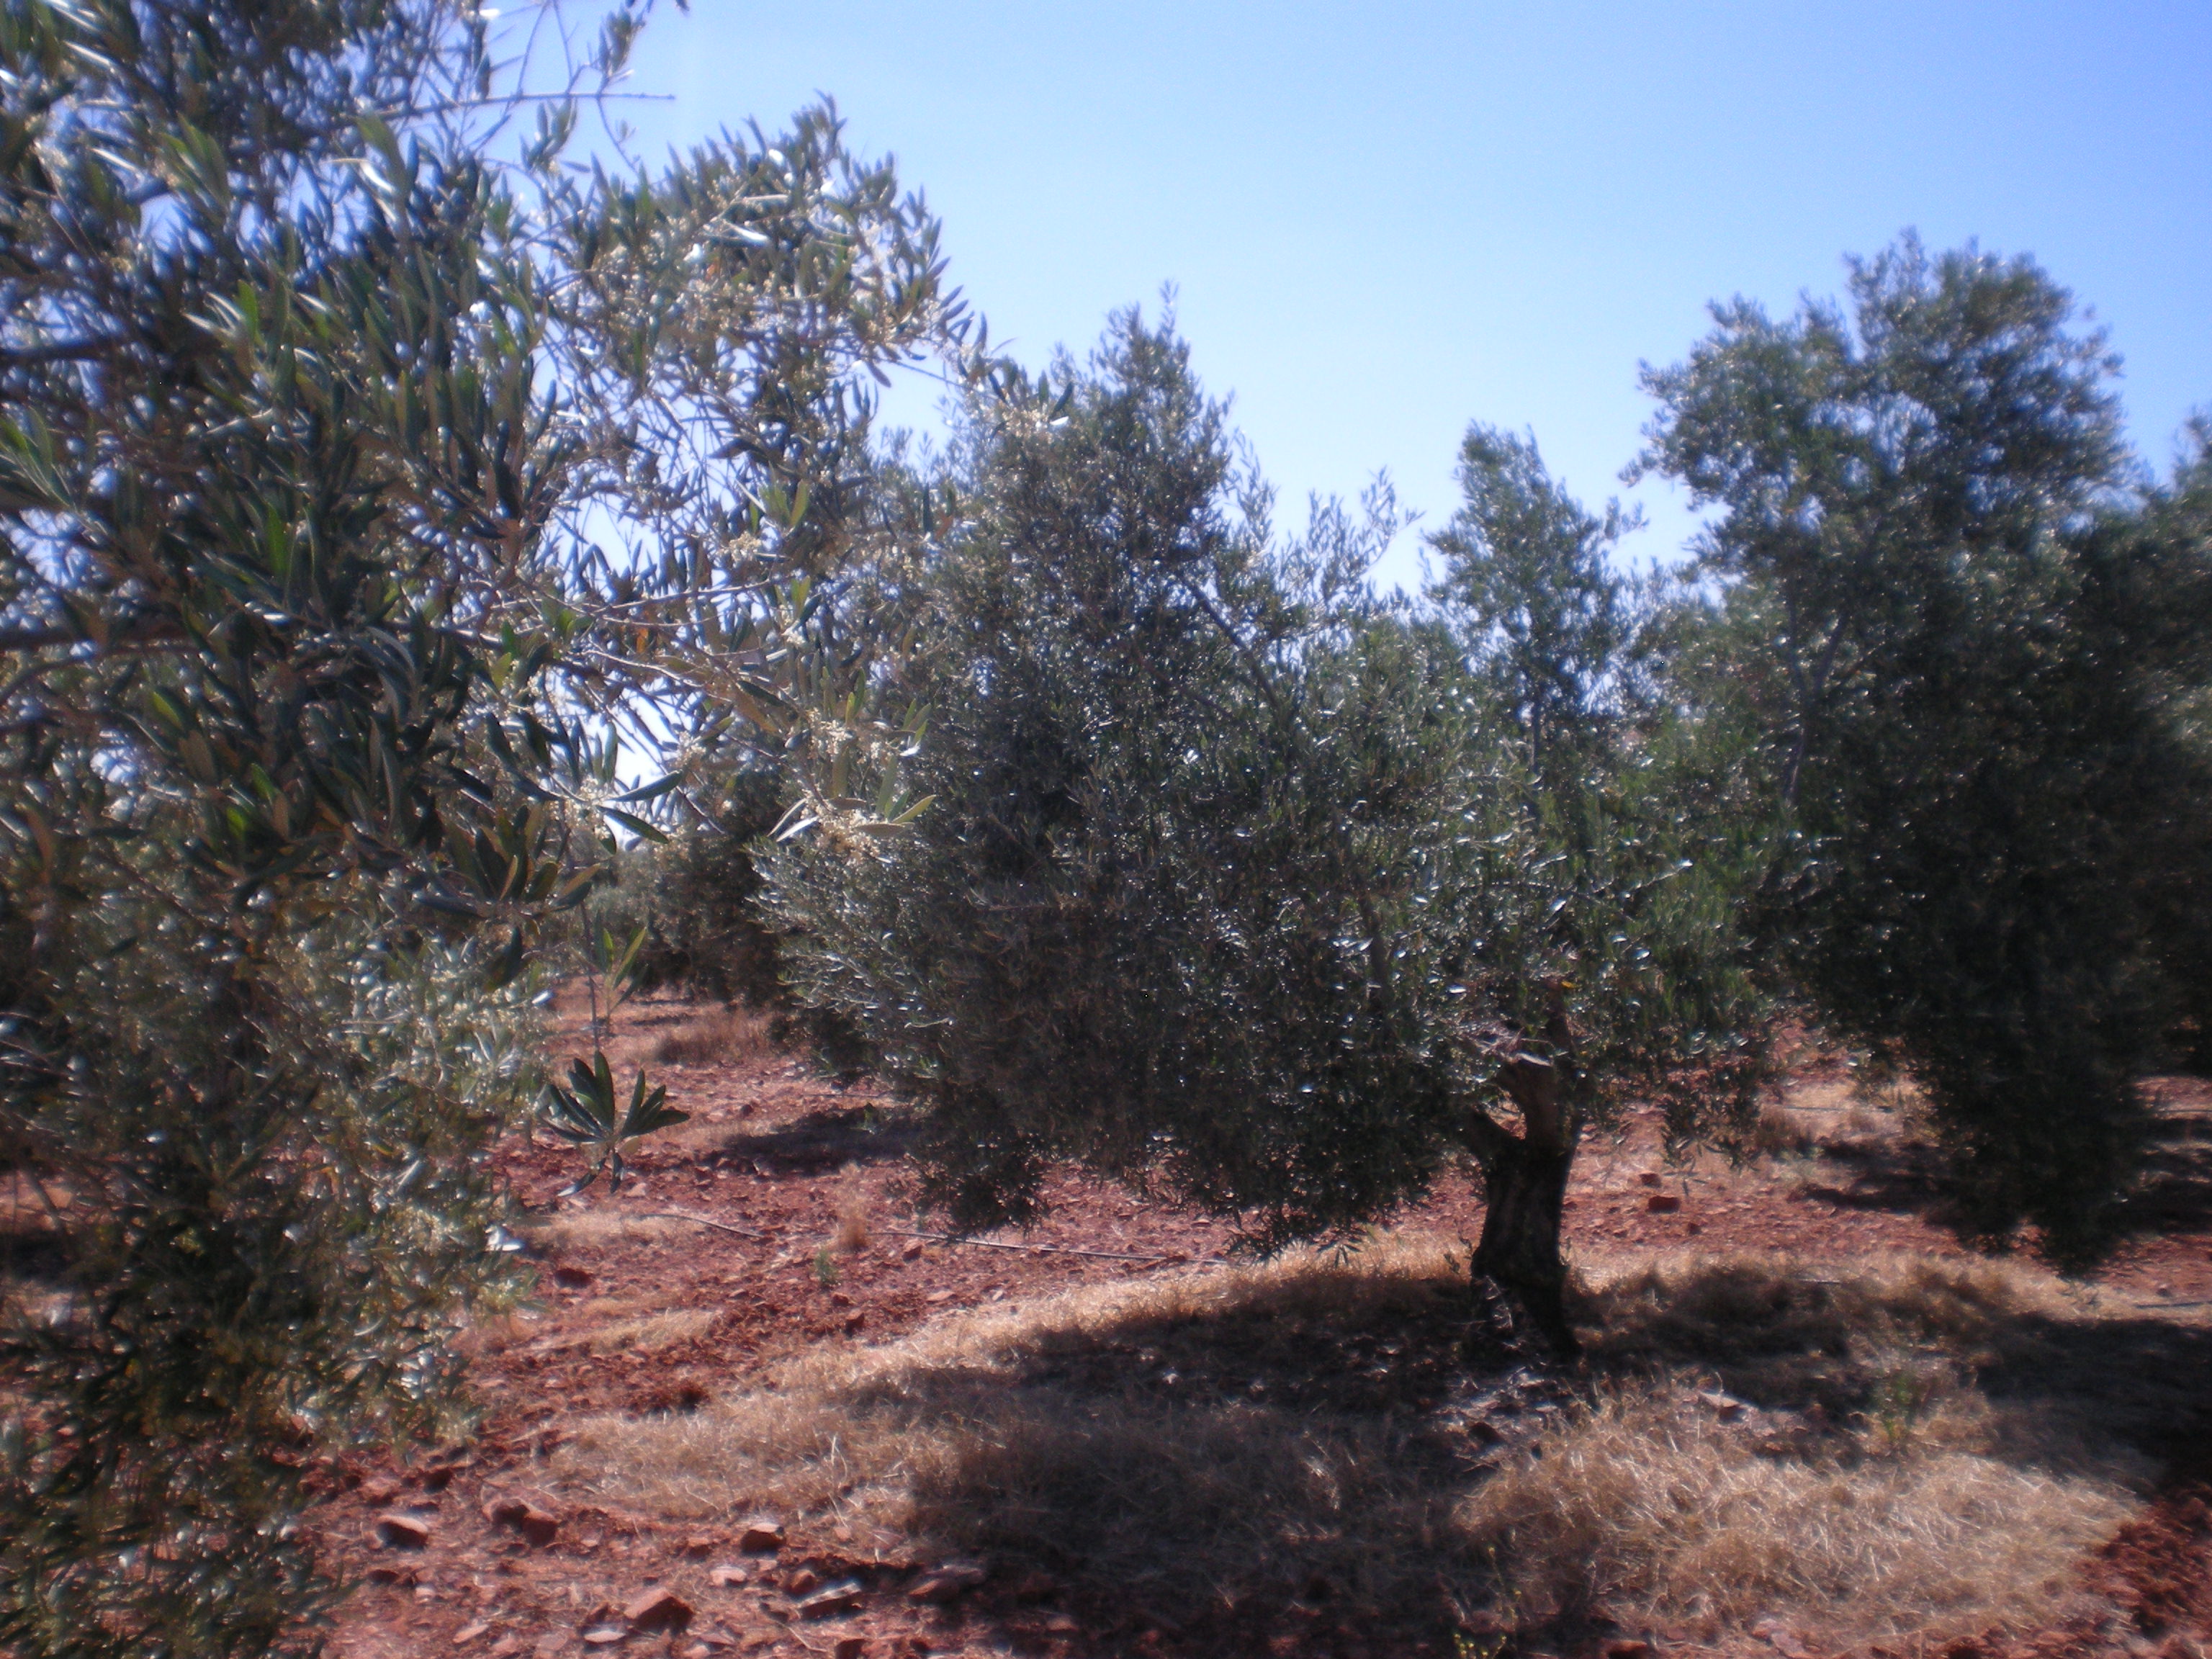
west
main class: Cropland
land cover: Olive groves
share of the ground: 10 - 25 %
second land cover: Other bare soil
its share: > 75 %
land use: Agriculture (excluding fallow land and kitchen gardens)
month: May
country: ES
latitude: 38.7255
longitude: -3.3645
